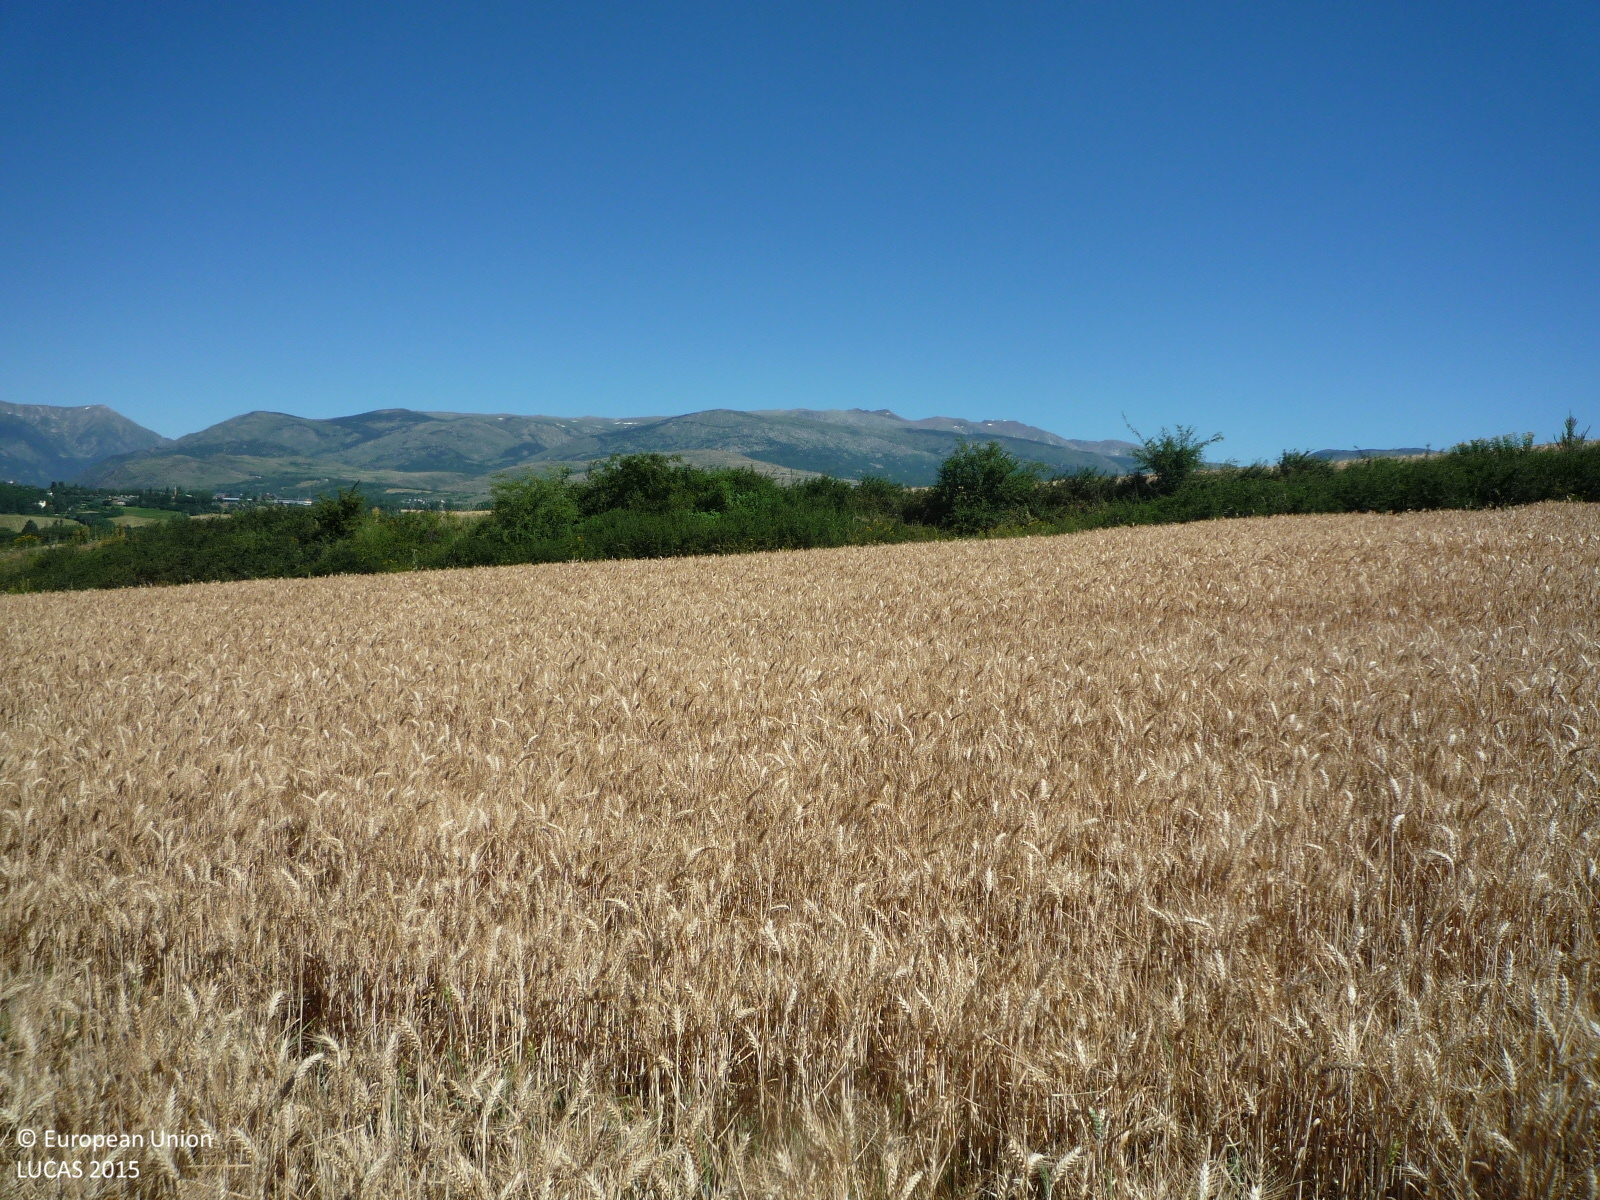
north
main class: Cropland
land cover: Common wheat
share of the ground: > 75 %
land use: Agriculture (excluding fallow land and kitchen gardens)
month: July
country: ES
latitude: 42.4242
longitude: 1.9532
